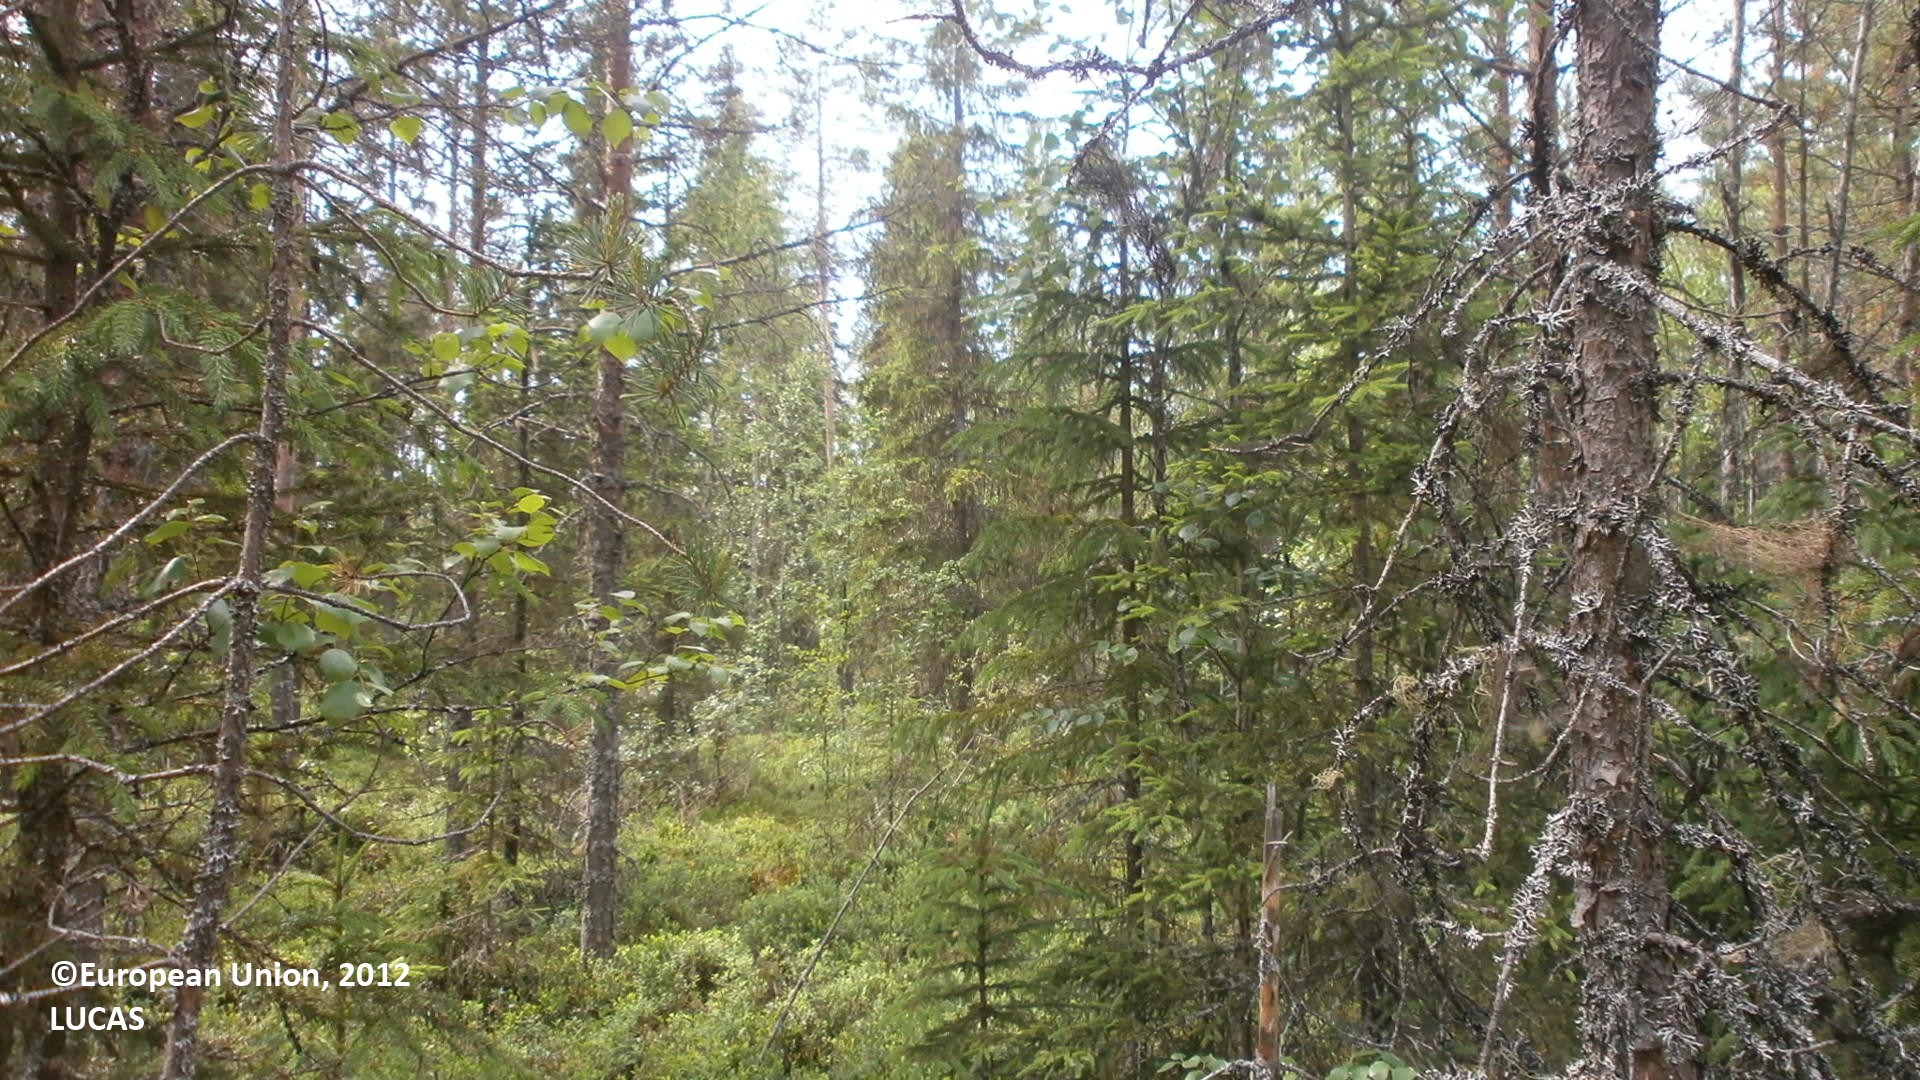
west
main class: Woodland
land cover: Spruce dominated mixed woodland
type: boreal forest
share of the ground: 50 - 75 %
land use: Forestry
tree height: > 5 m
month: July
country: FI
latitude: 64.0486
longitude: 24.8064
